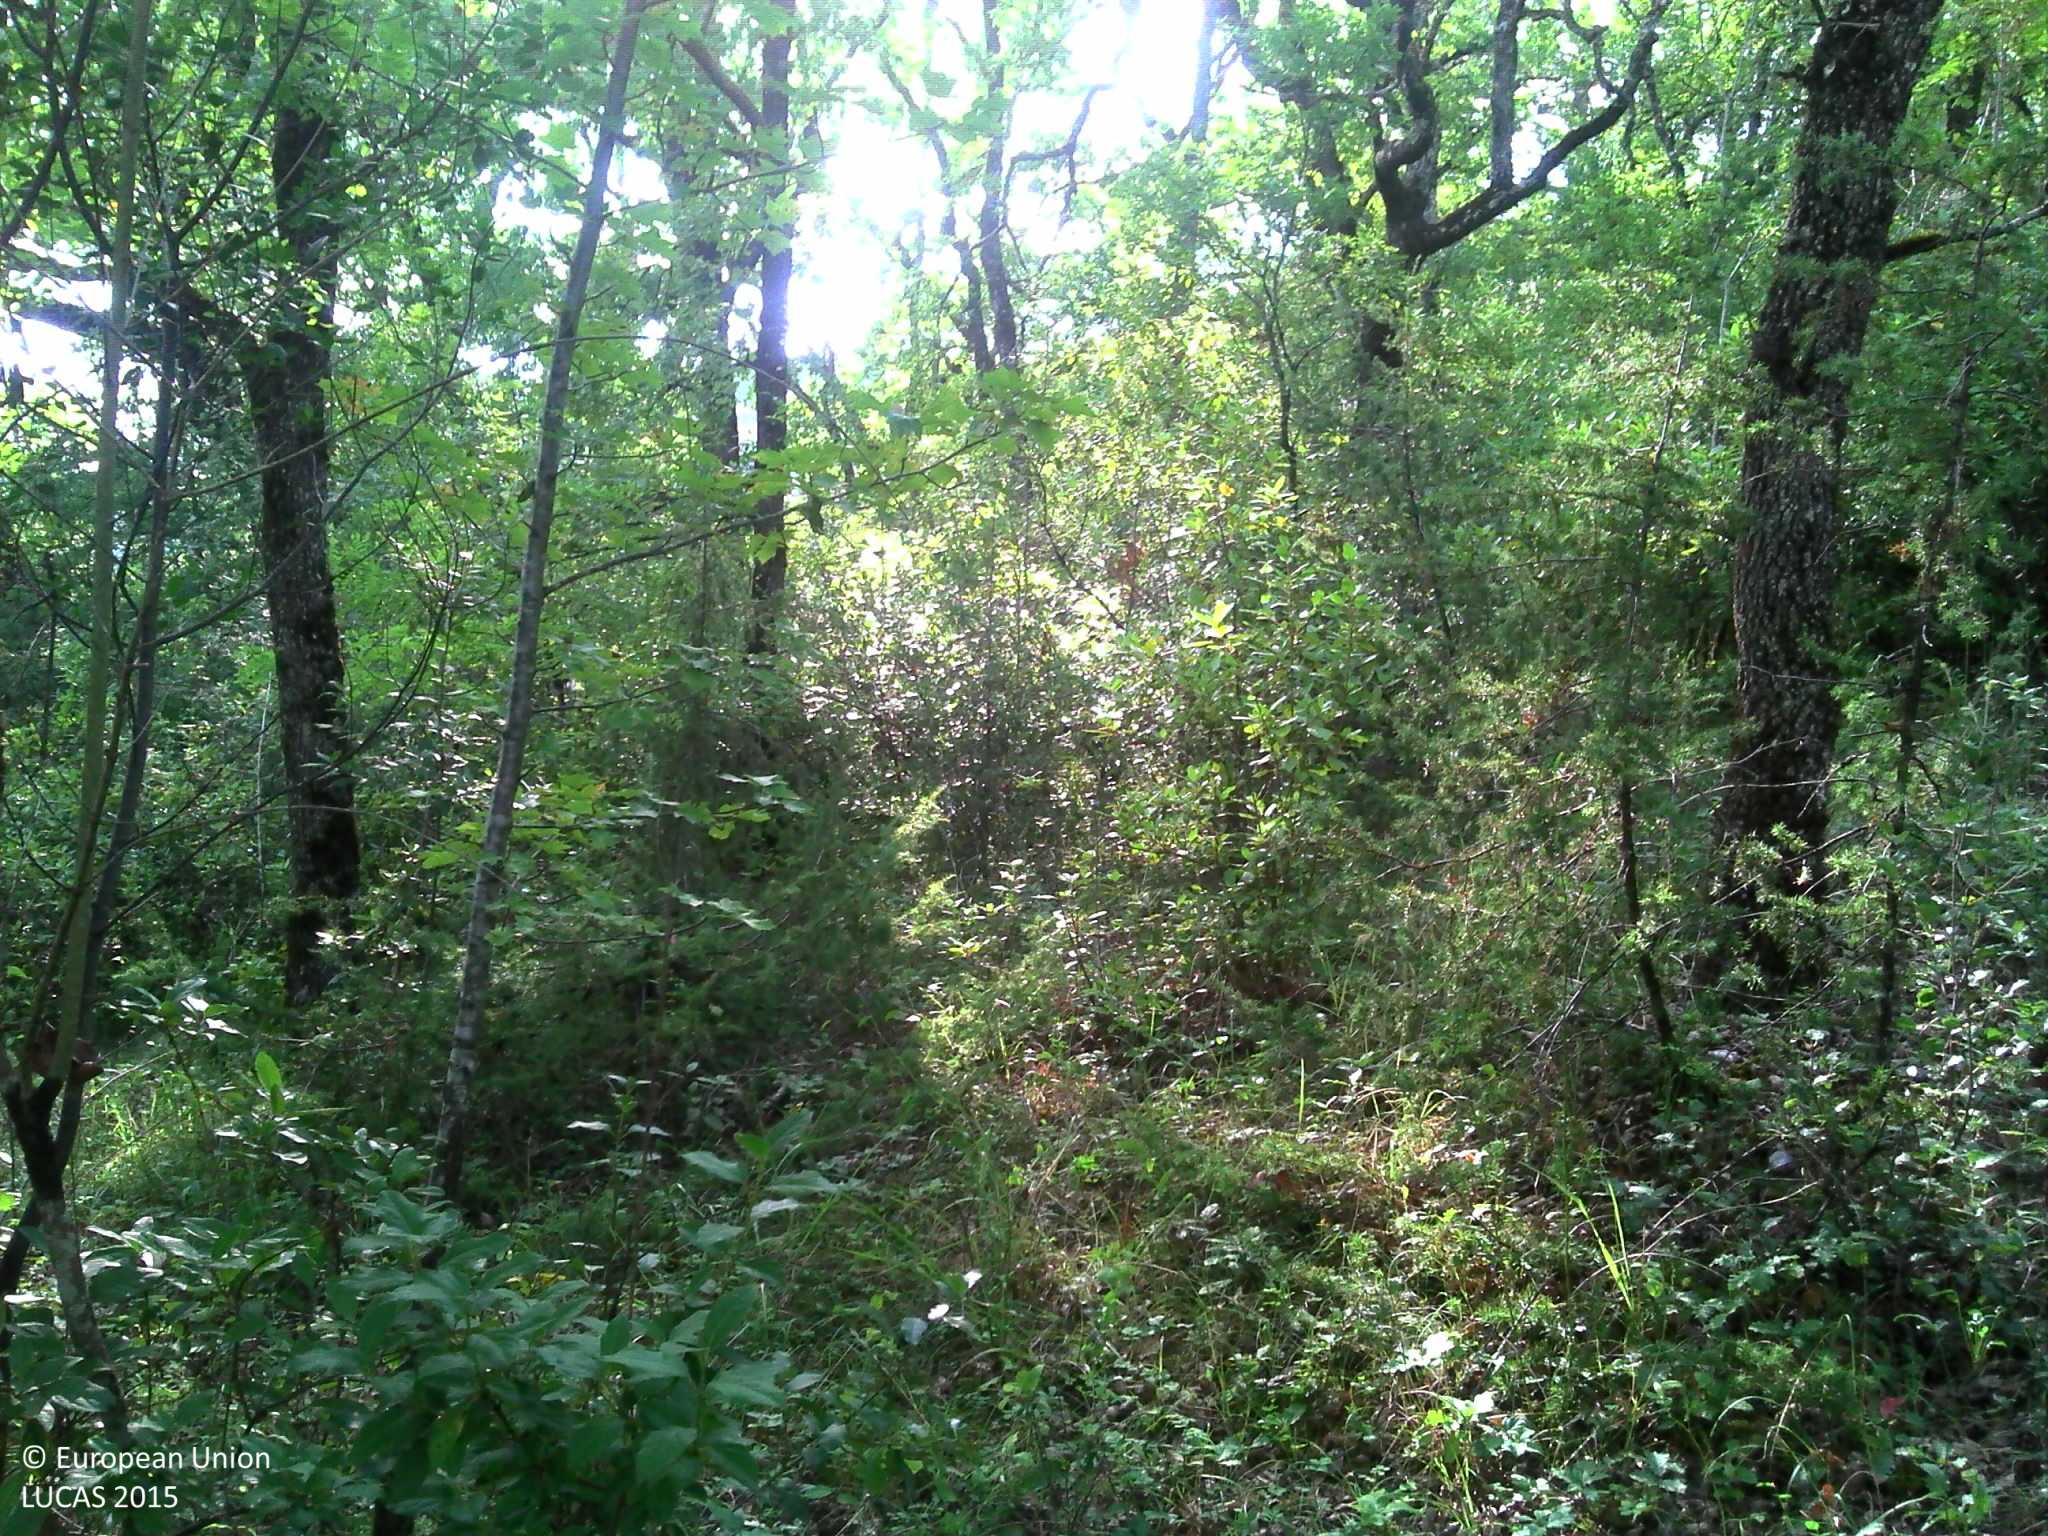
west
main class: Woodland
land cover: Broadleaved woodland
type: thermophilous deciduous forest
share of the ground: > 75 %
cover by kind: broadleaved forest trees 80 %, shrubs 10 %, herbaceous plants 10 %
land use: Residential
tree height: > 5 m
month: August
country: FR
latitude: 44.4887
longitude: 1.2577
